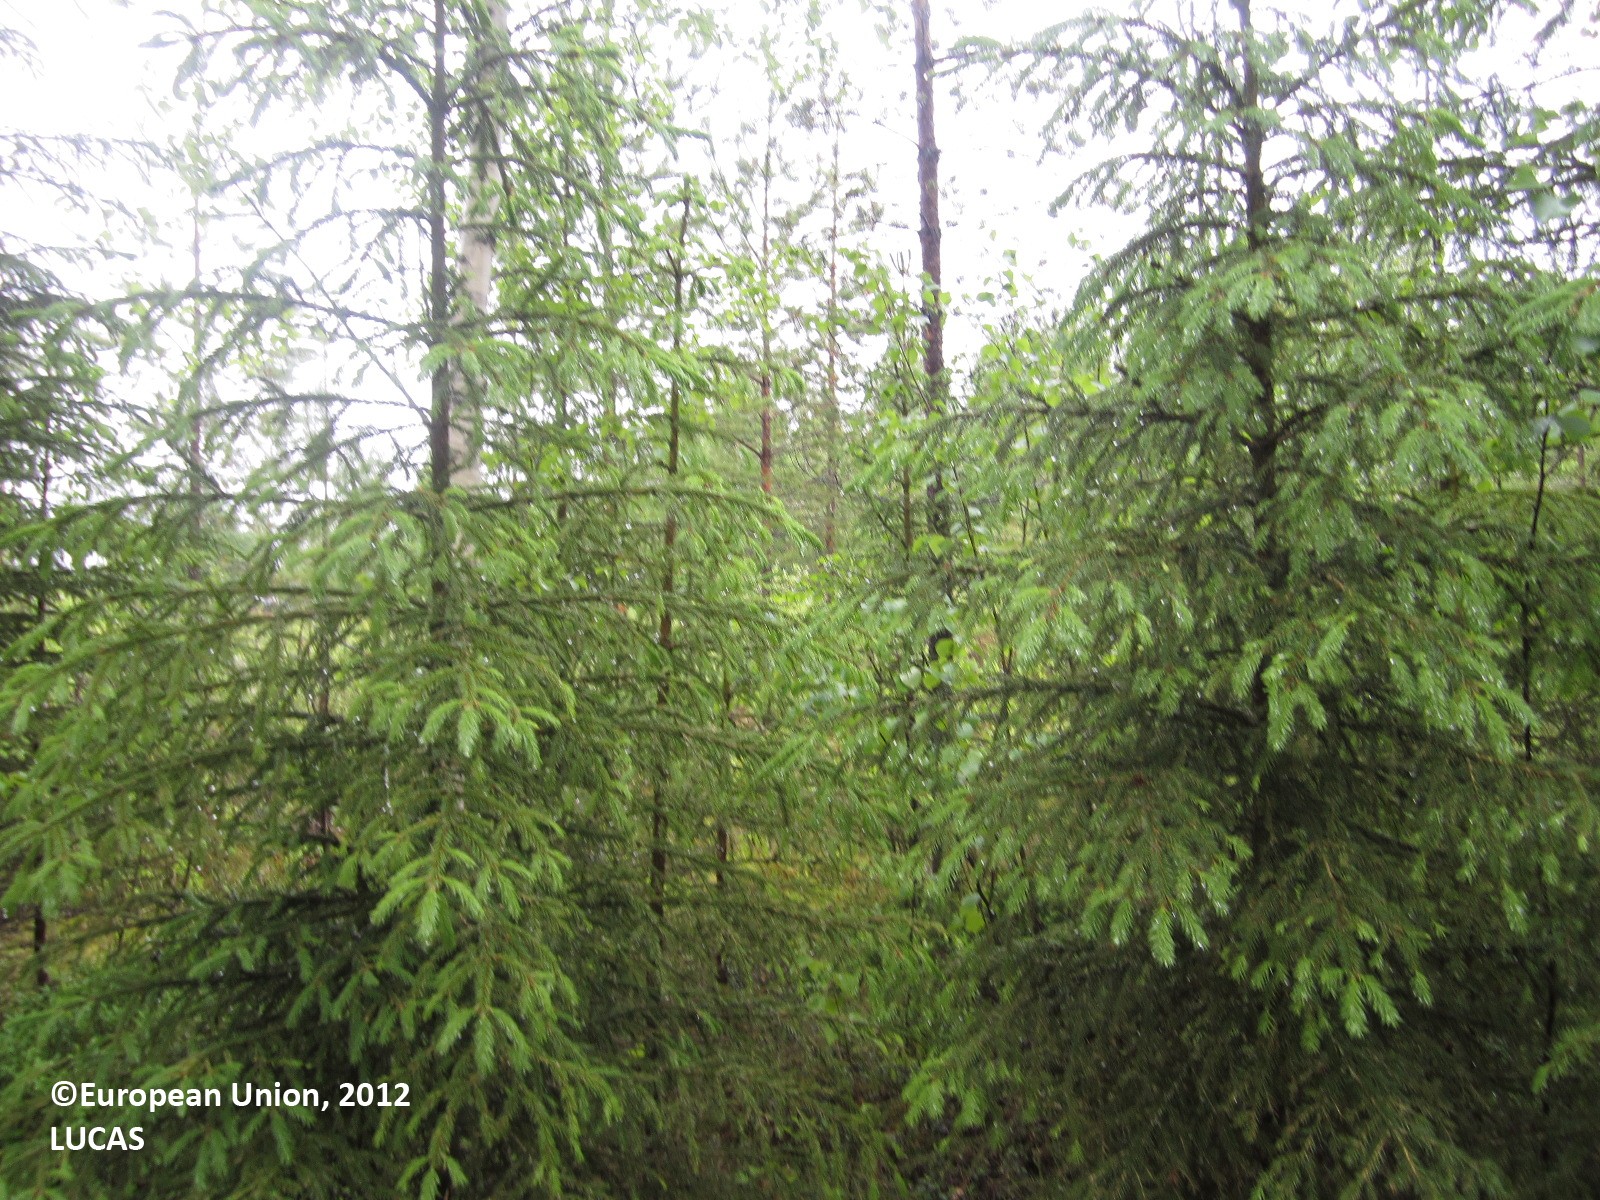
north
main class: Woodland
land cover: Spruce dominated mixed woodland
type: boreal forest
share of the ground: 50 - 75 %
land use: Forestry
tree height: > 5 m
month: June
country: FI
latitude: 64.3892
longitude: 29.4765
